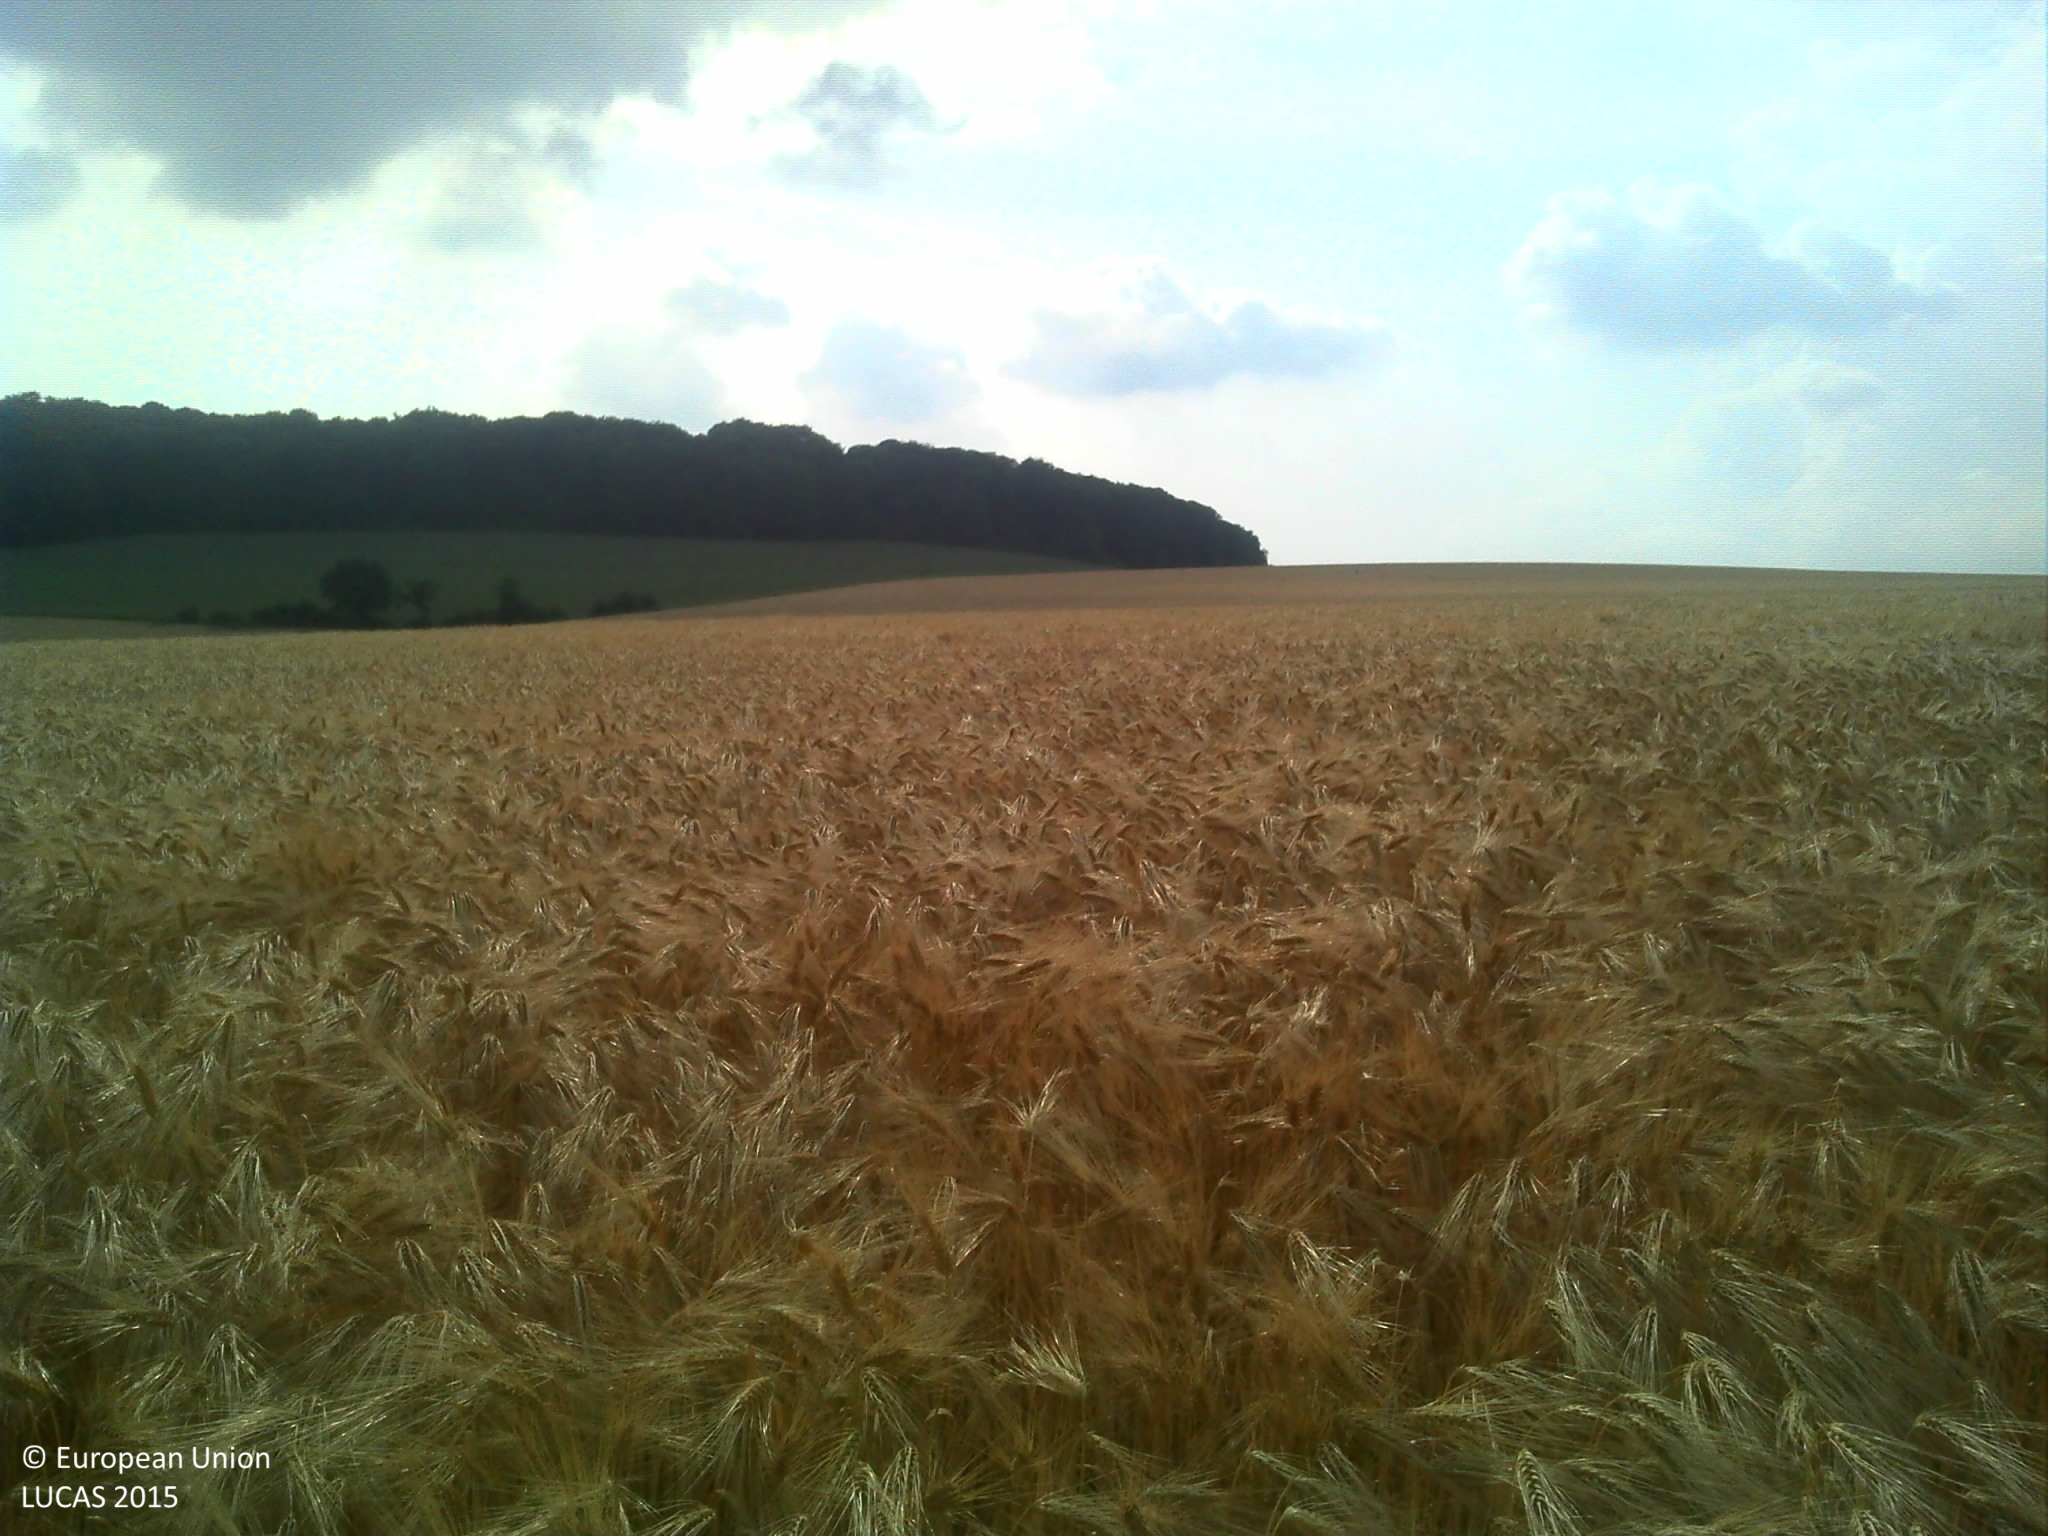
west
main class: Cropland
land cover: Barley
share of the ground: > 75 %
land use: Agriculture (excluding fallow land and kitchen gardens)
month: June
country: FR
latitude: 48.2662
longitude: 4.8657
